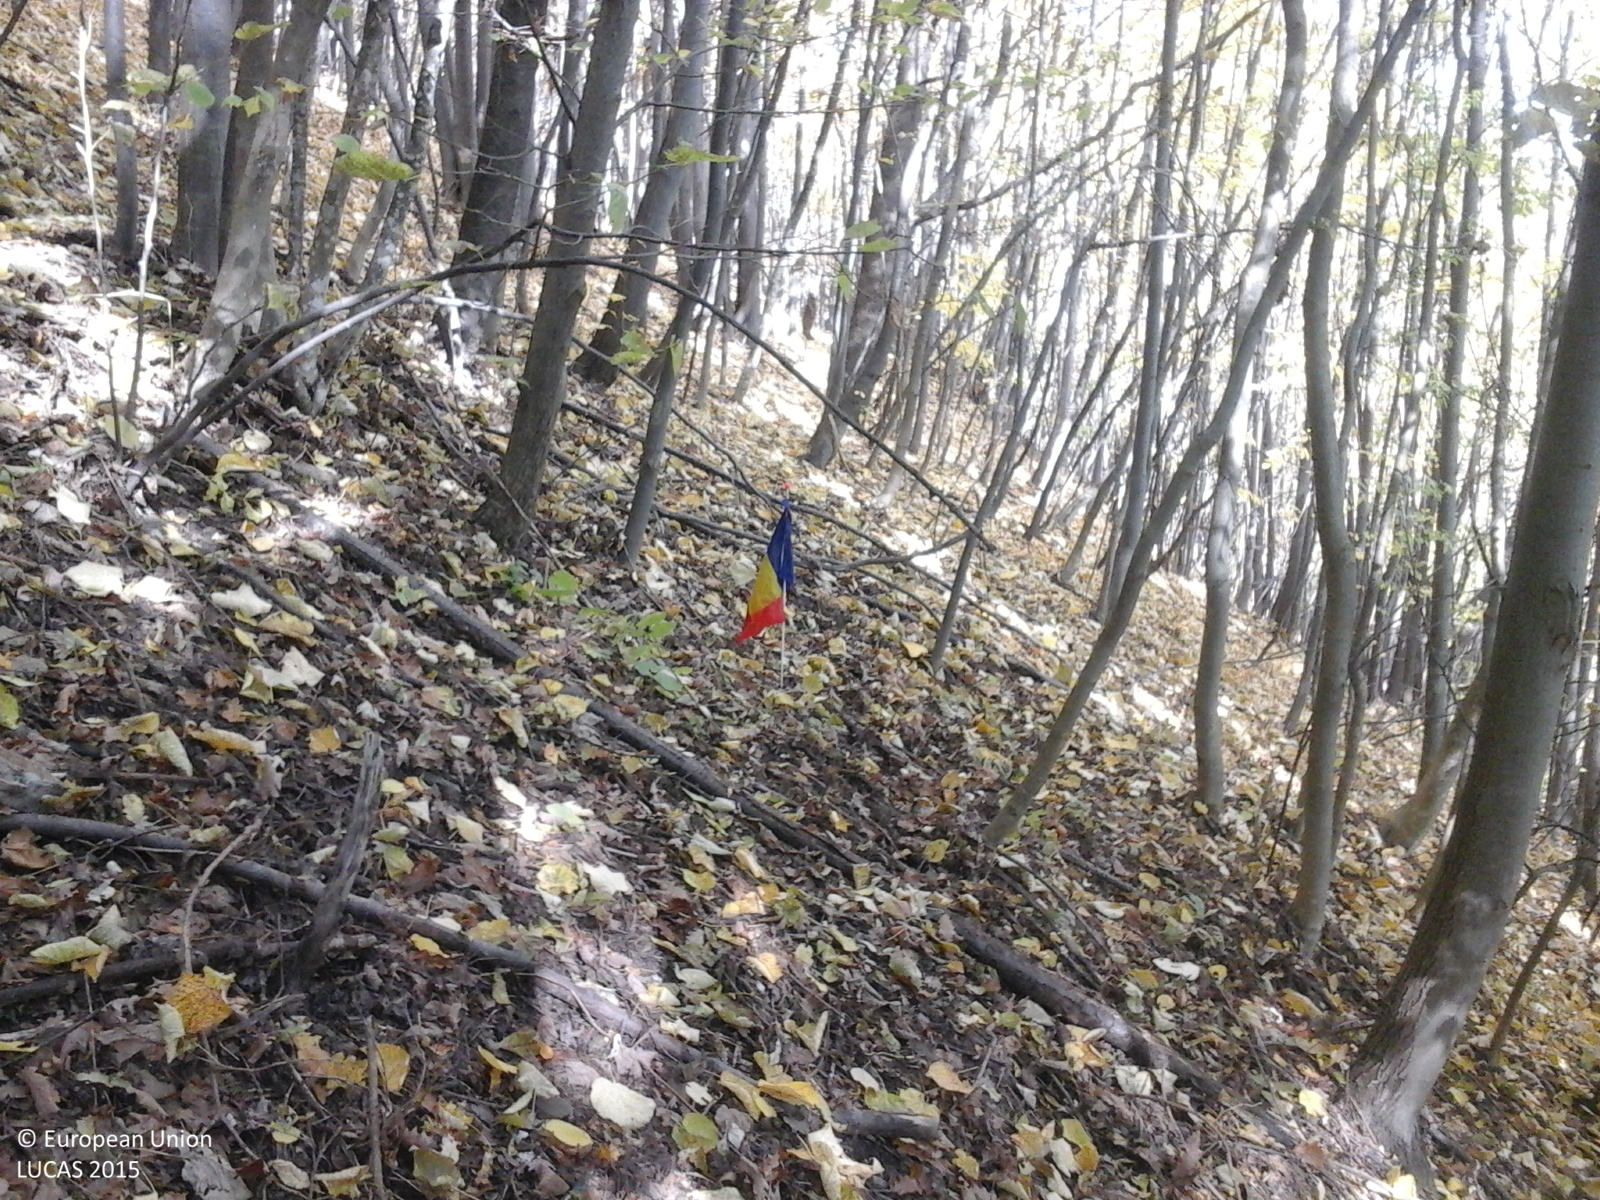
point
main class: Woodland
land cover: Broadleaved woodland
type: non-riverine alder, birch or aspen forest
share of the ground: > 75 %
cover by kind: broadleaved forest trees 100 %
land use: Forestry
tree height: > 5 m
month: October
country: RO
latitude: 45.4980
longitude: 26.6243
